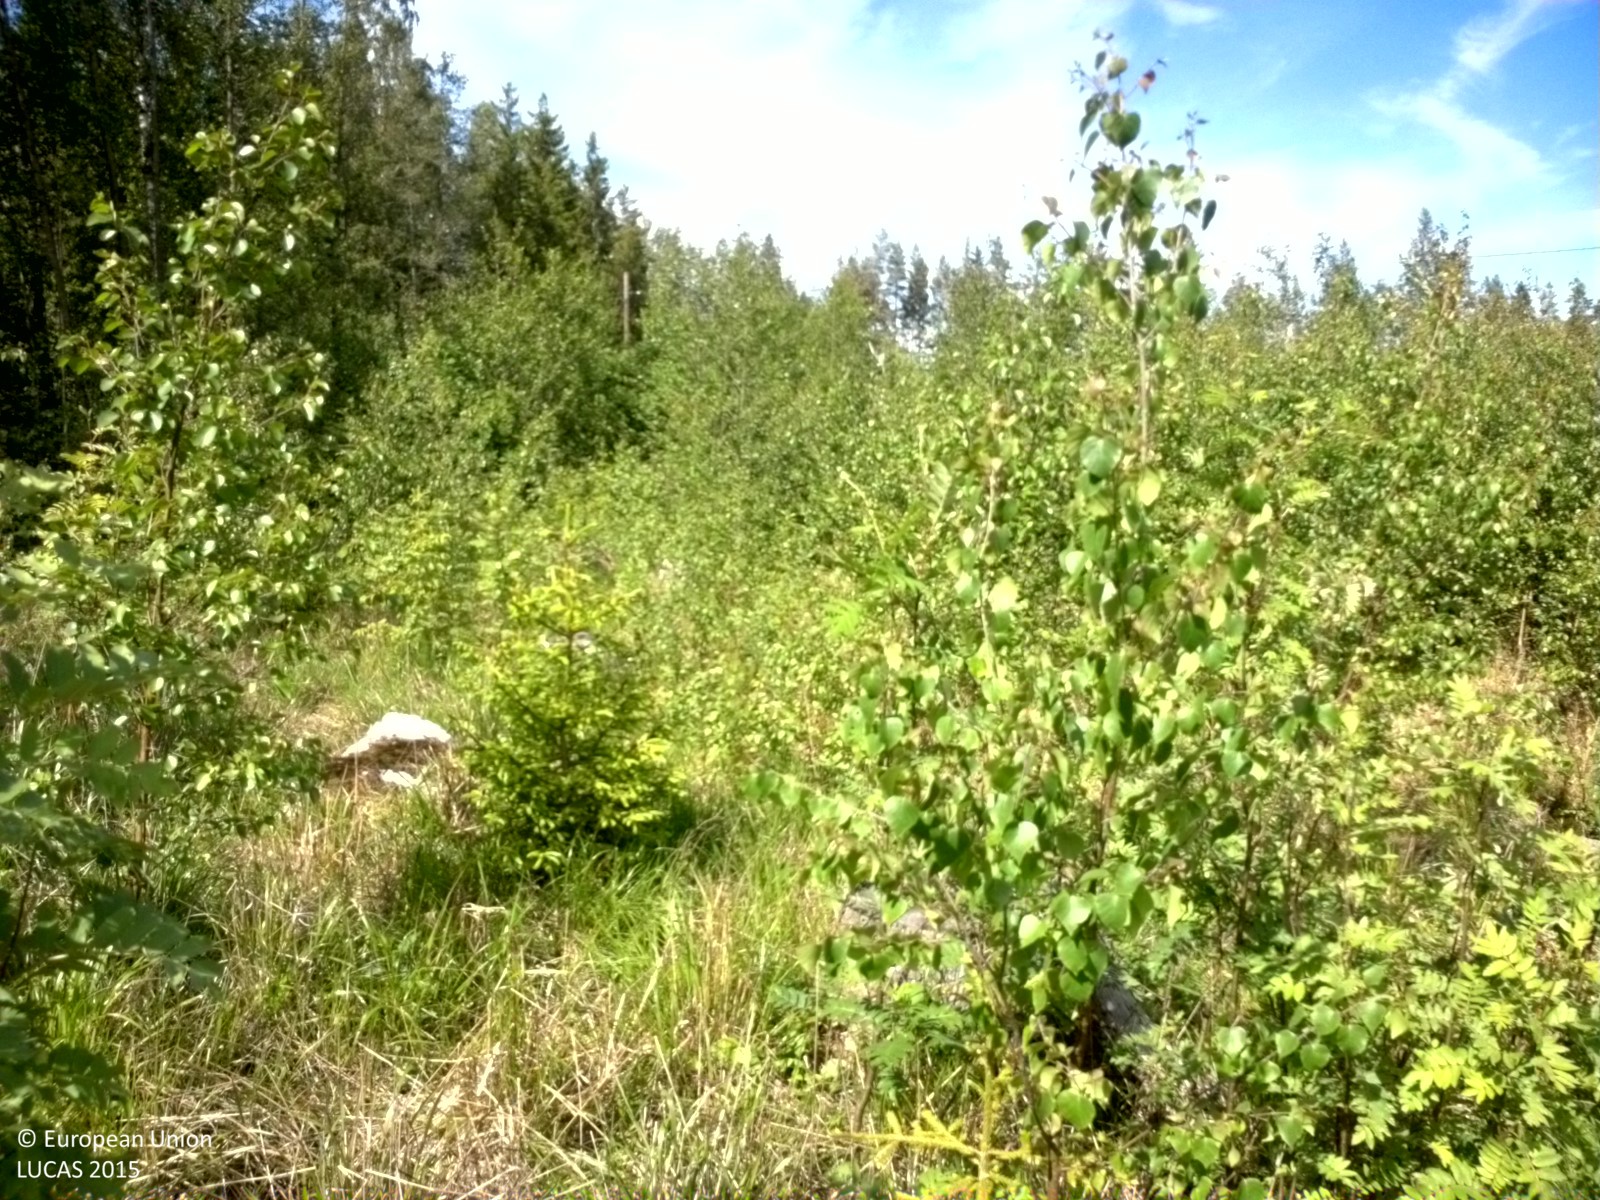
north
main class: Woodland
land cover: Broadleaved woodland
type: boreal forest
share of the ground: 50 - 75 %
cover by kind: broadleaved forest trees 50 %, herbaceous plants 30 %, coniferous forest trees 5 %, shrubs 5 %, lichens and mosses 5 %
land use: Forestry
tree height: < 5 m
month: June
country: SE
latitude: 60.3073
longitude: 17.1395
